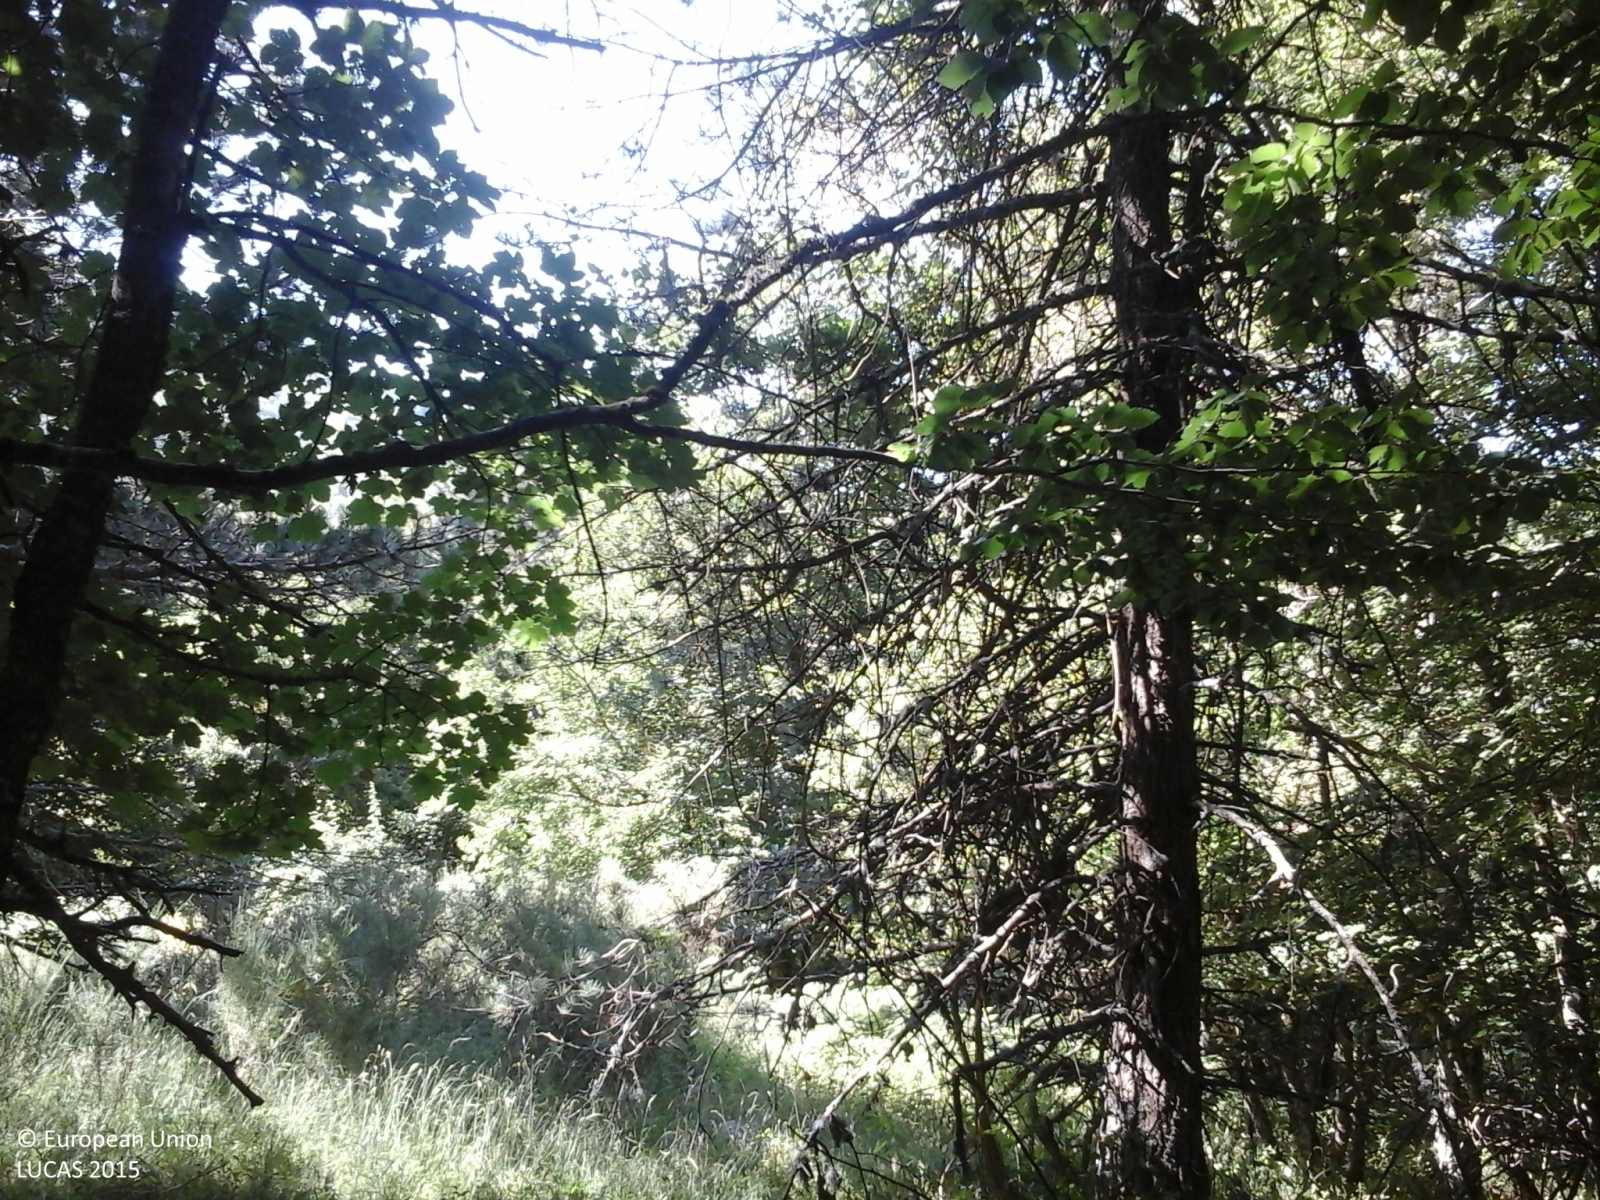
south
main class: Woodland
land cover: Other mixed woodland
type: mountainous beech forest
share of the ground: > 75 %
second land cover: Grassland without tree/shrub cover
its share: > 75 %
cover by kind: coniferous forest trees 40 %, broadleaved forest trees 35 %, herbaceous plants 15 %, shrubs 10 %
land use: Forestry
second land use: Agriculture (excluding fallow land and kitchen gardens)
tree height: > 5 m
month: July
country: IT
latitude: 40.8216
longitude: 15.1374
